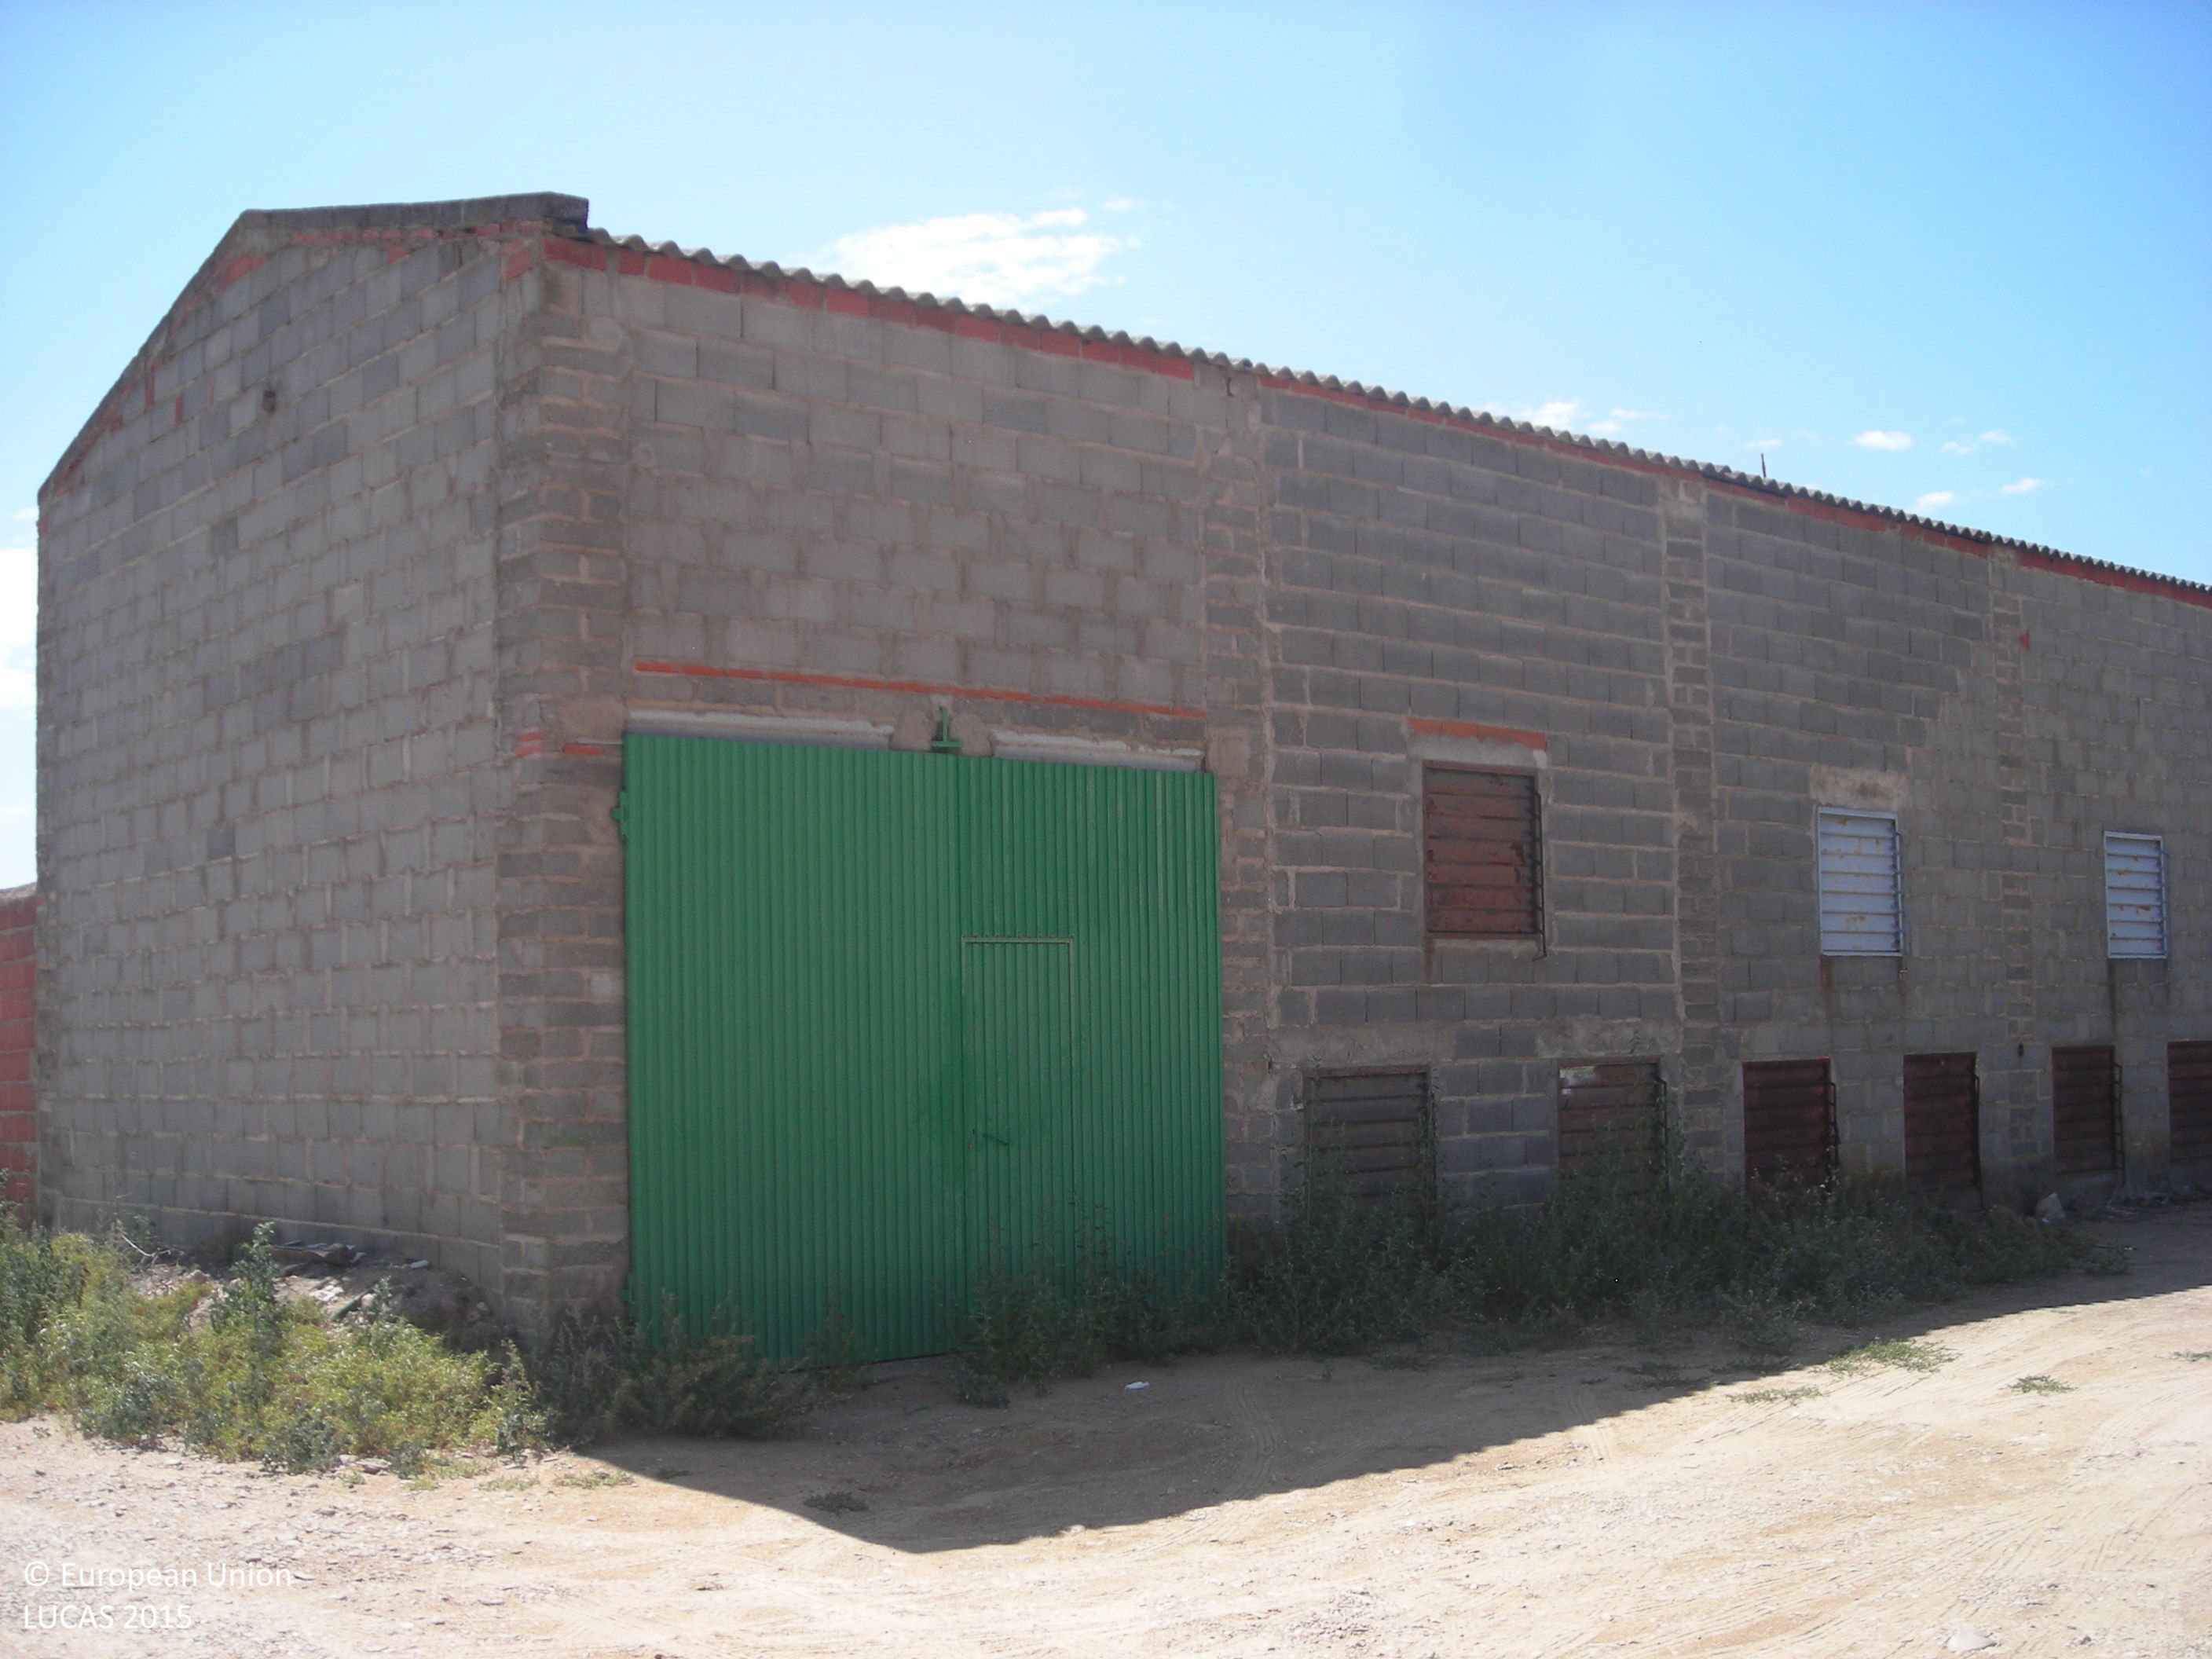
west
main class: Cropland
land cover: Olive groves
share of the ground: 25 - 50 %
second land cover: Other bare soil
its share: > 75 %
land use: Agriculture (excluding fallow land and kitchen gardens)
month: July
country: ES
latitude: 38.9685
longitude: -5.9673
